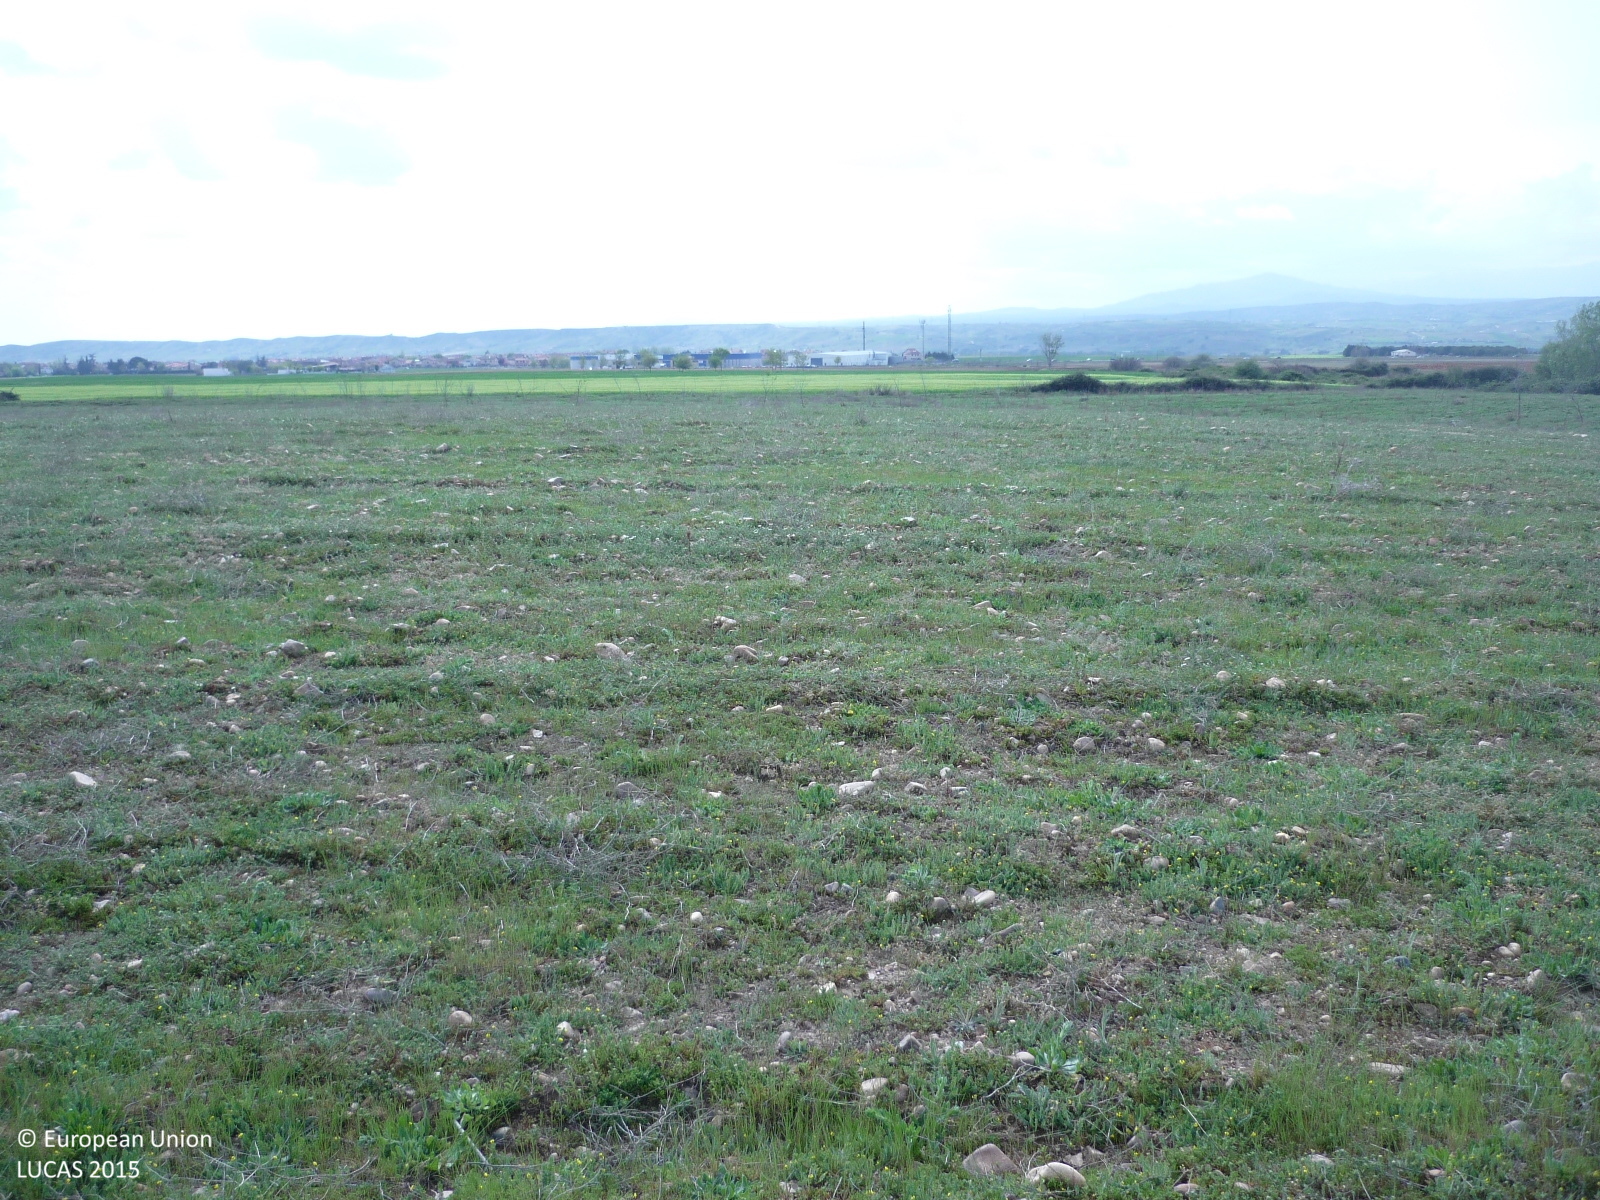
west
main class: Grassland
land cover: Spontaneously vegetated surfaces
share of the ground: > 75 %
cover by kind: herbaceous plants 95 %, consolidated bare surface 5 %
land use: Fallow land
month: April
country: ES
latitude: 40.7034
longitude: -3.4955
